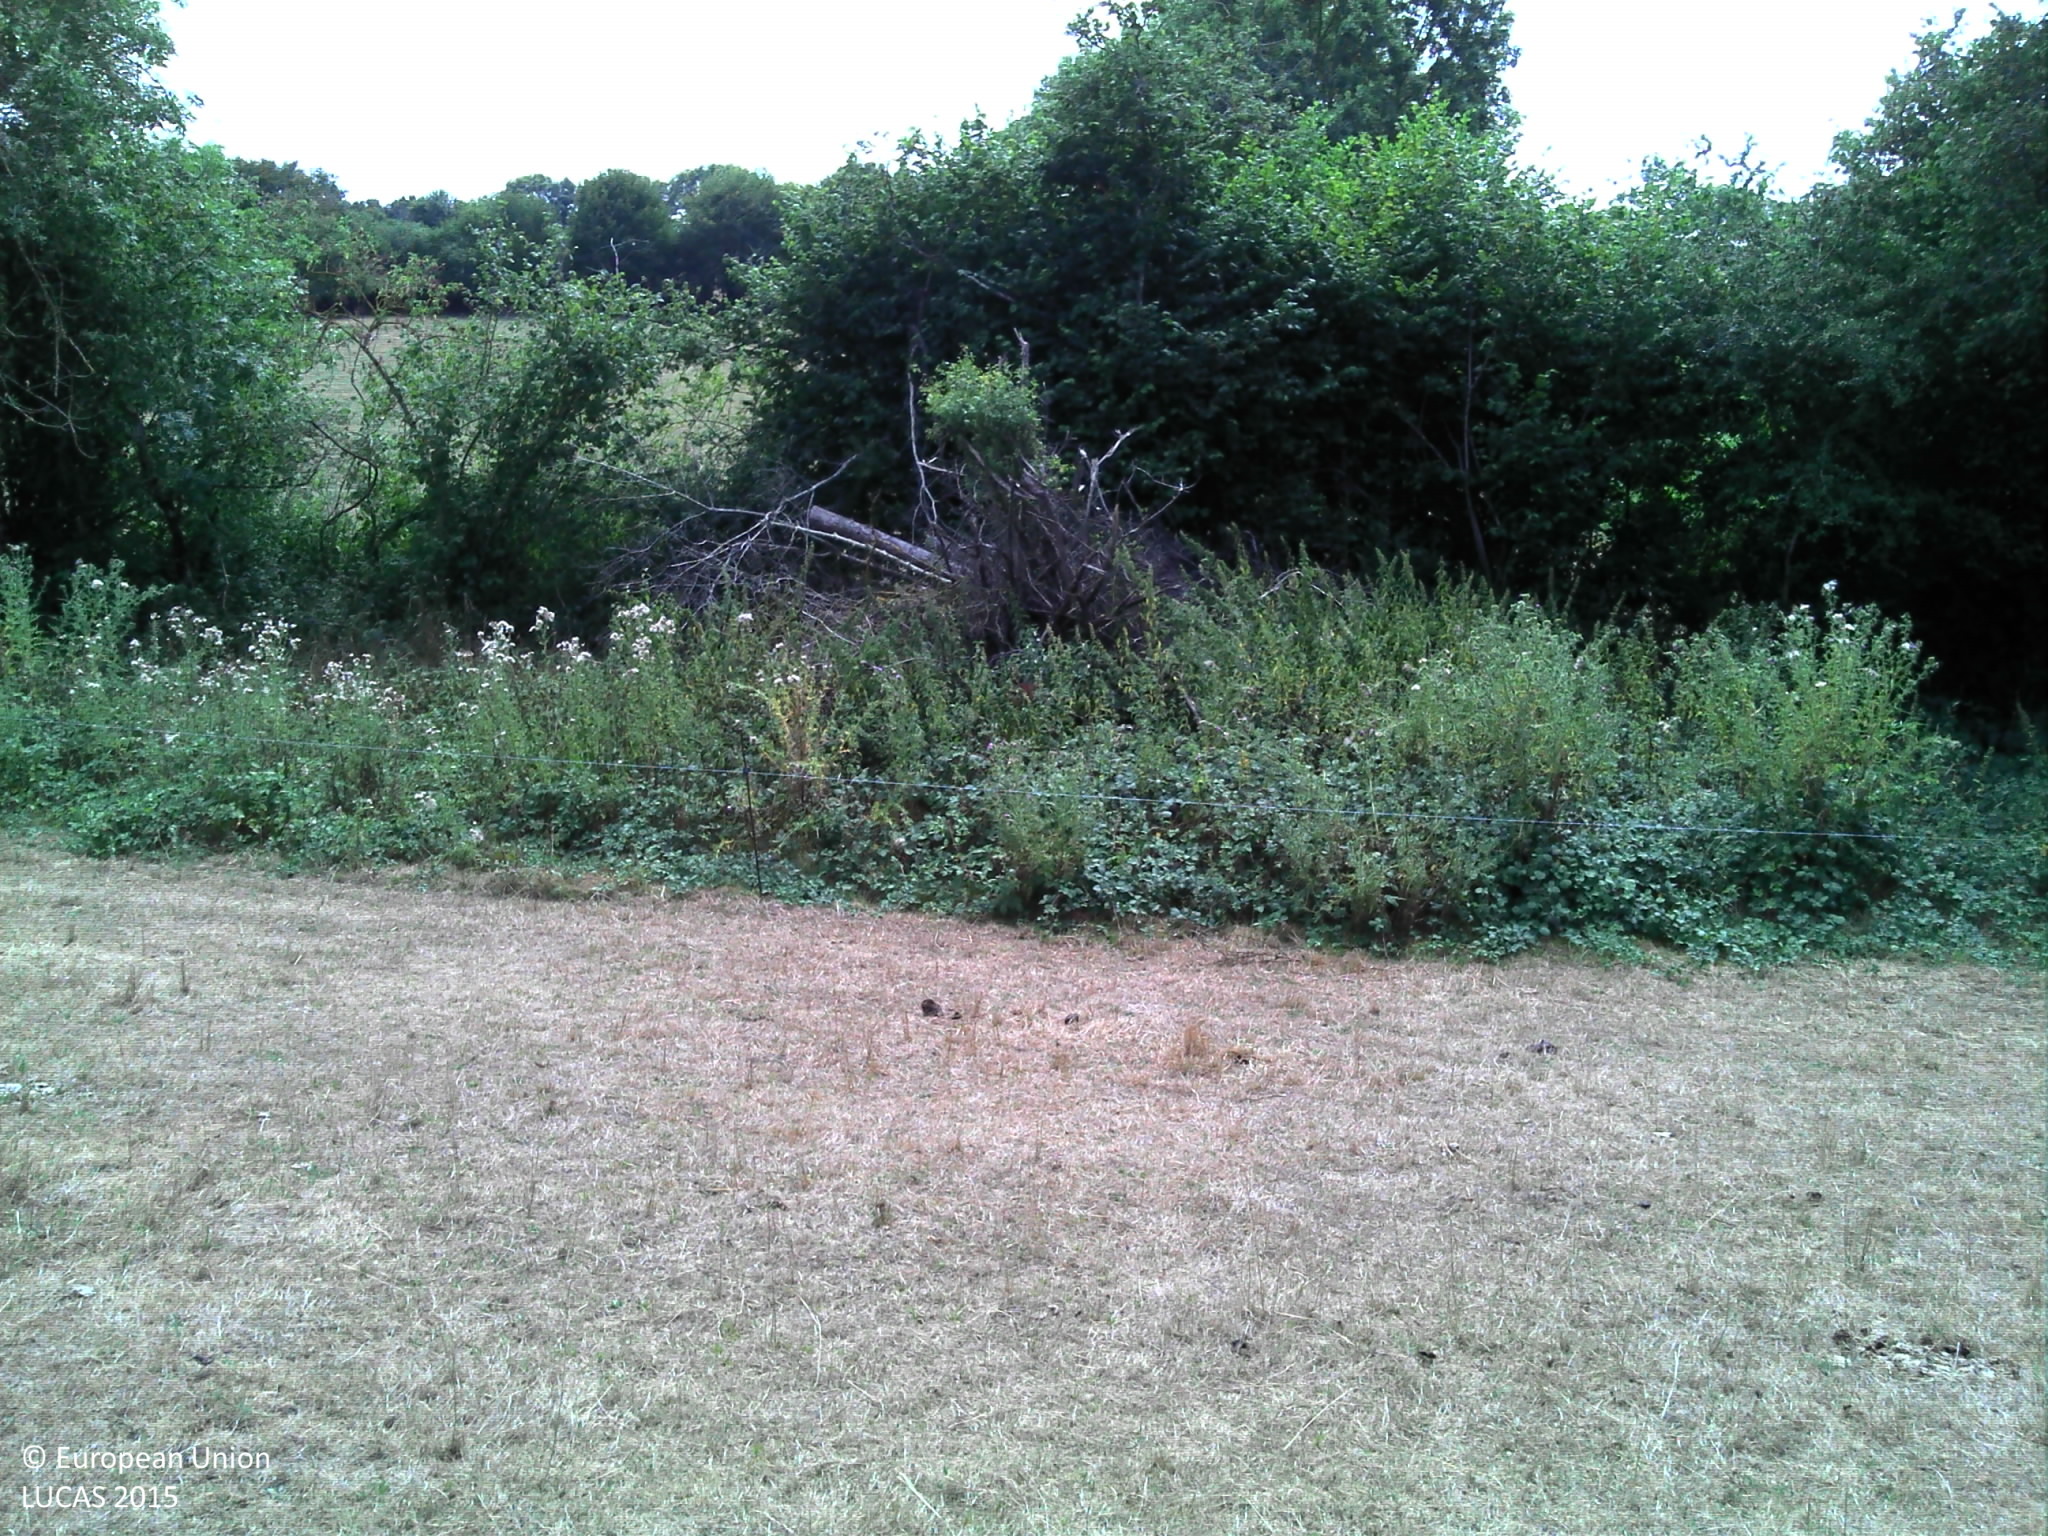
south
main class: Grassland
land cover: Grassland without tree/shrub cover
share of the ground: > 75 %
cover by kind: herbaceous plants 95 %, shrubs 5 %
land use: Agriculture (excluding fallow land and kitchen gardens)
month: August
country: FR
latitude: 47.7738
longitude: 3.1216
